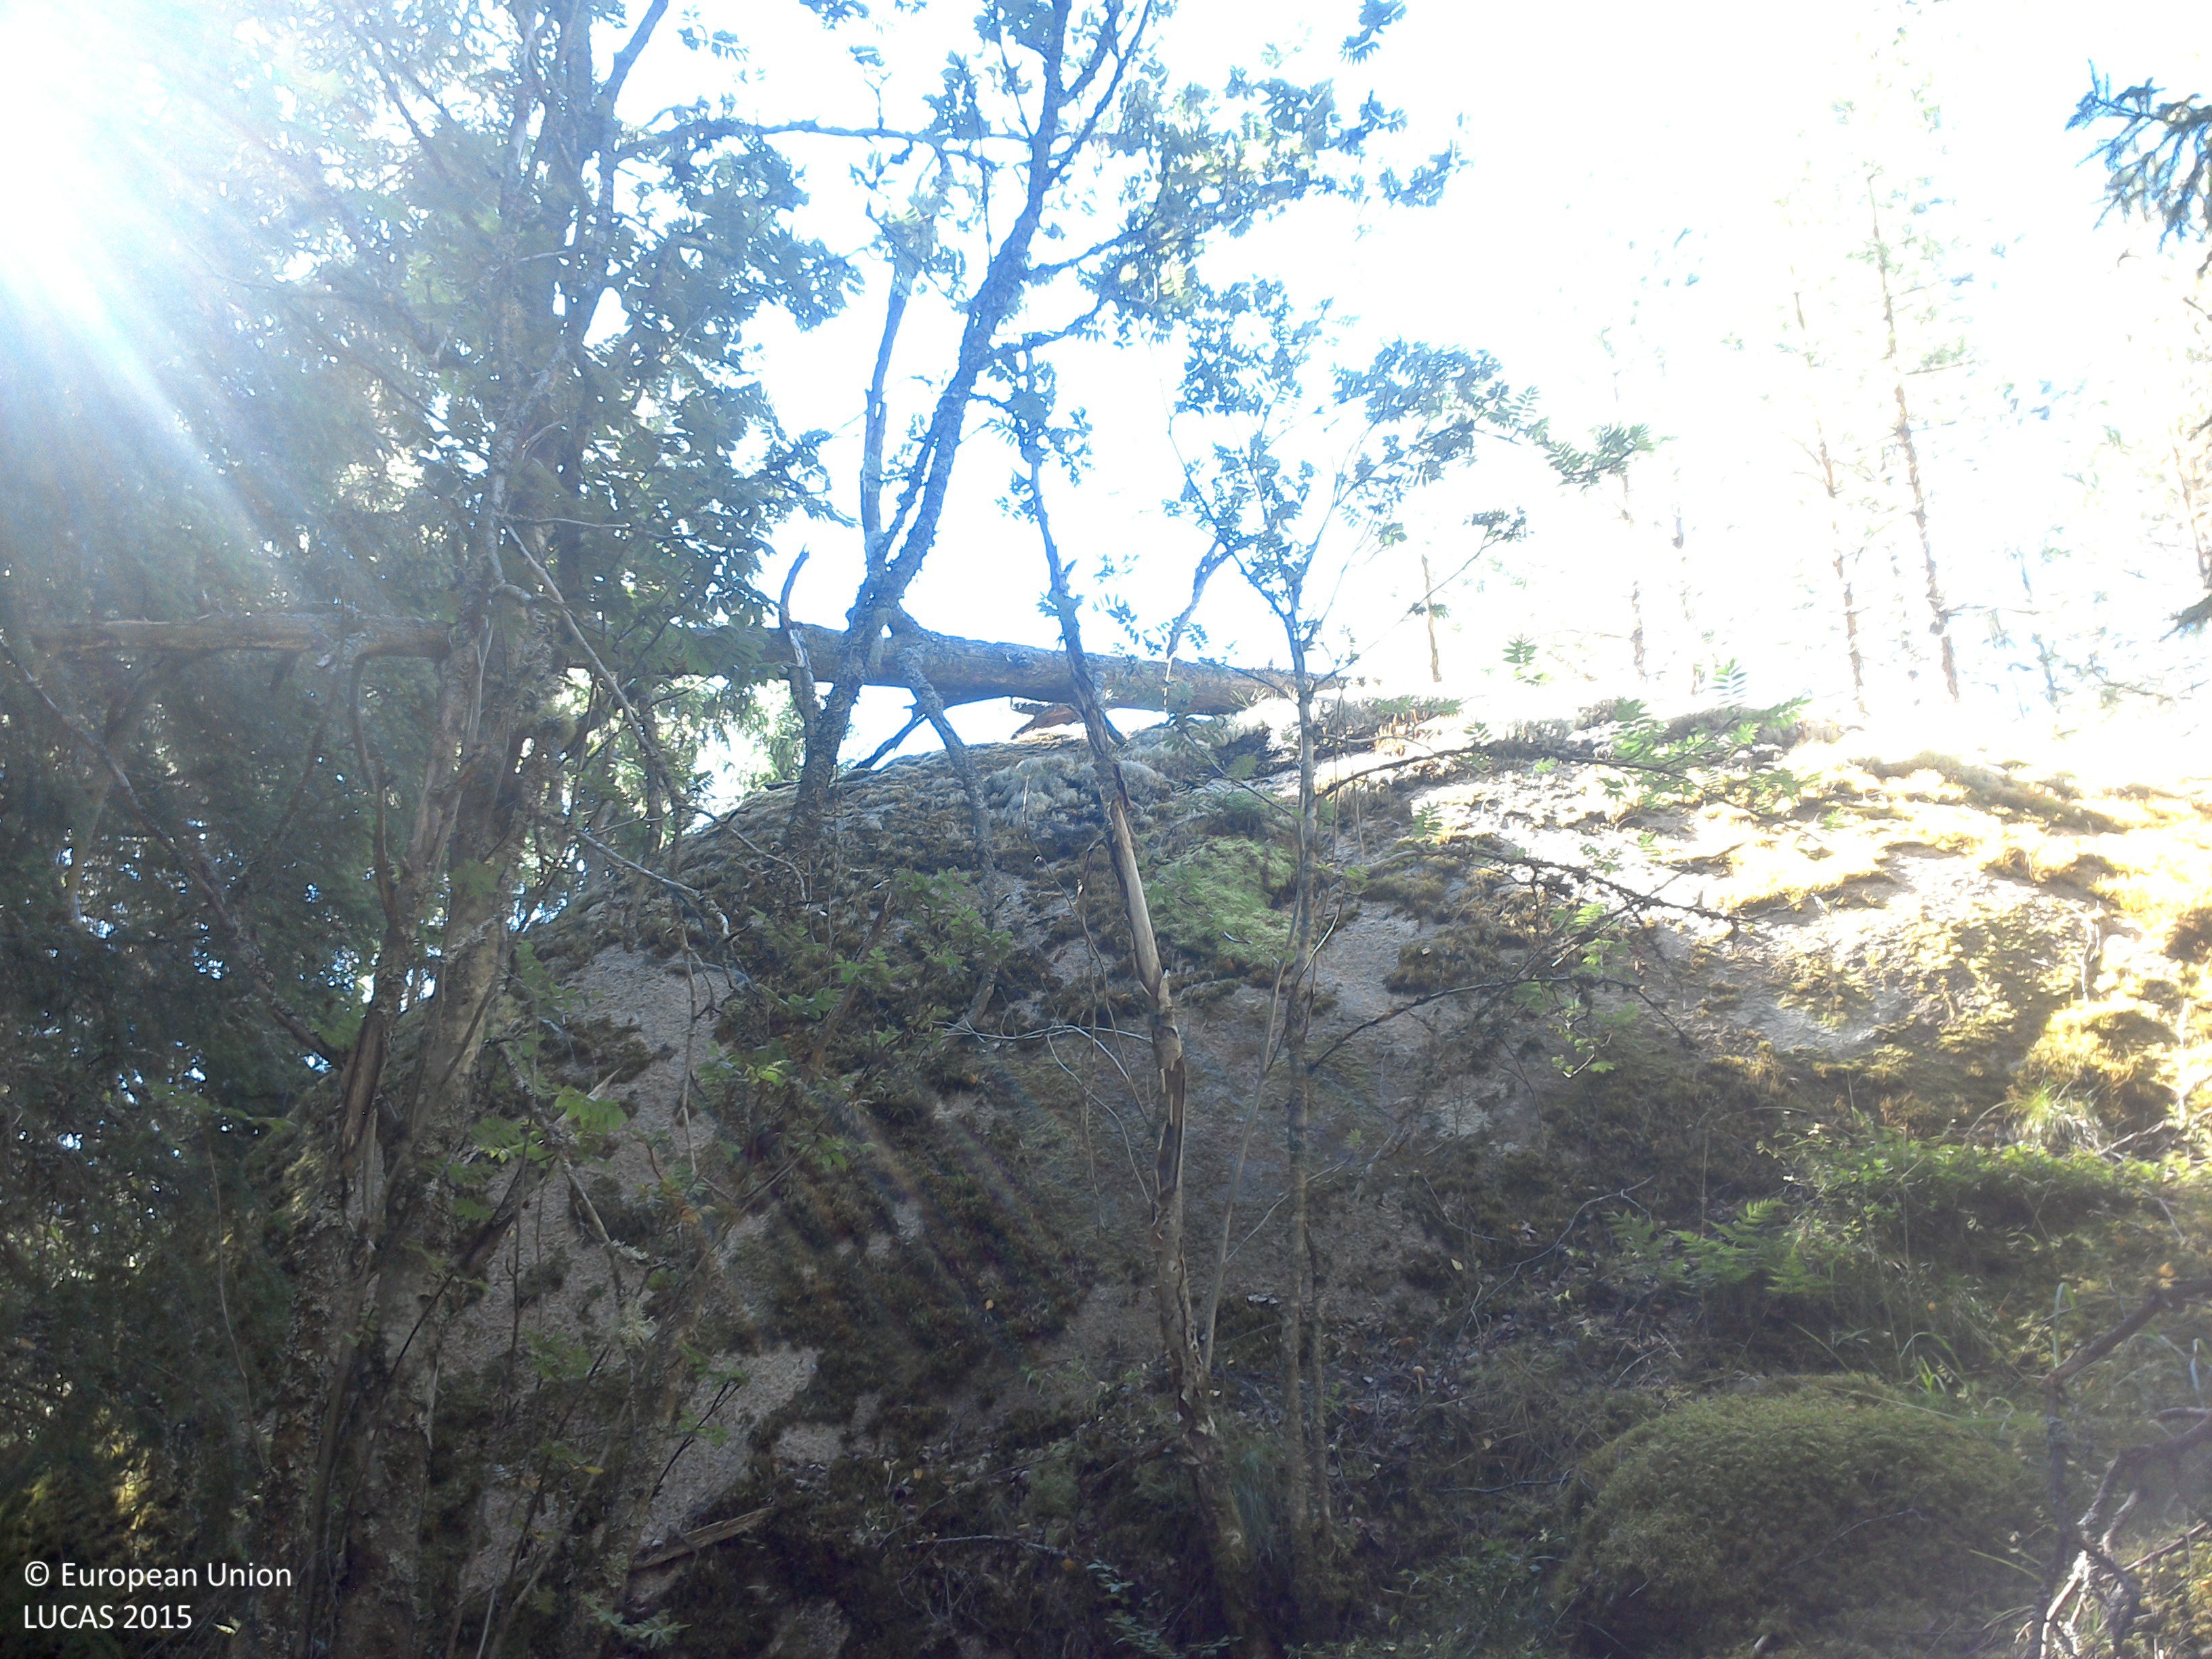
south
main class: Woodland
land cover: Pine dominated coniferous woodland
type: boreal forest
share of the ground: 25 - 50 %
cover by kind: coniferous forest trees 50 %, lichens and mosses 40 %, herbaceous plants 10 %
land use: Forestry
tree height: > 5 m
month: August
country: SE
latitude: 58.2148
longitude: 15.0498
